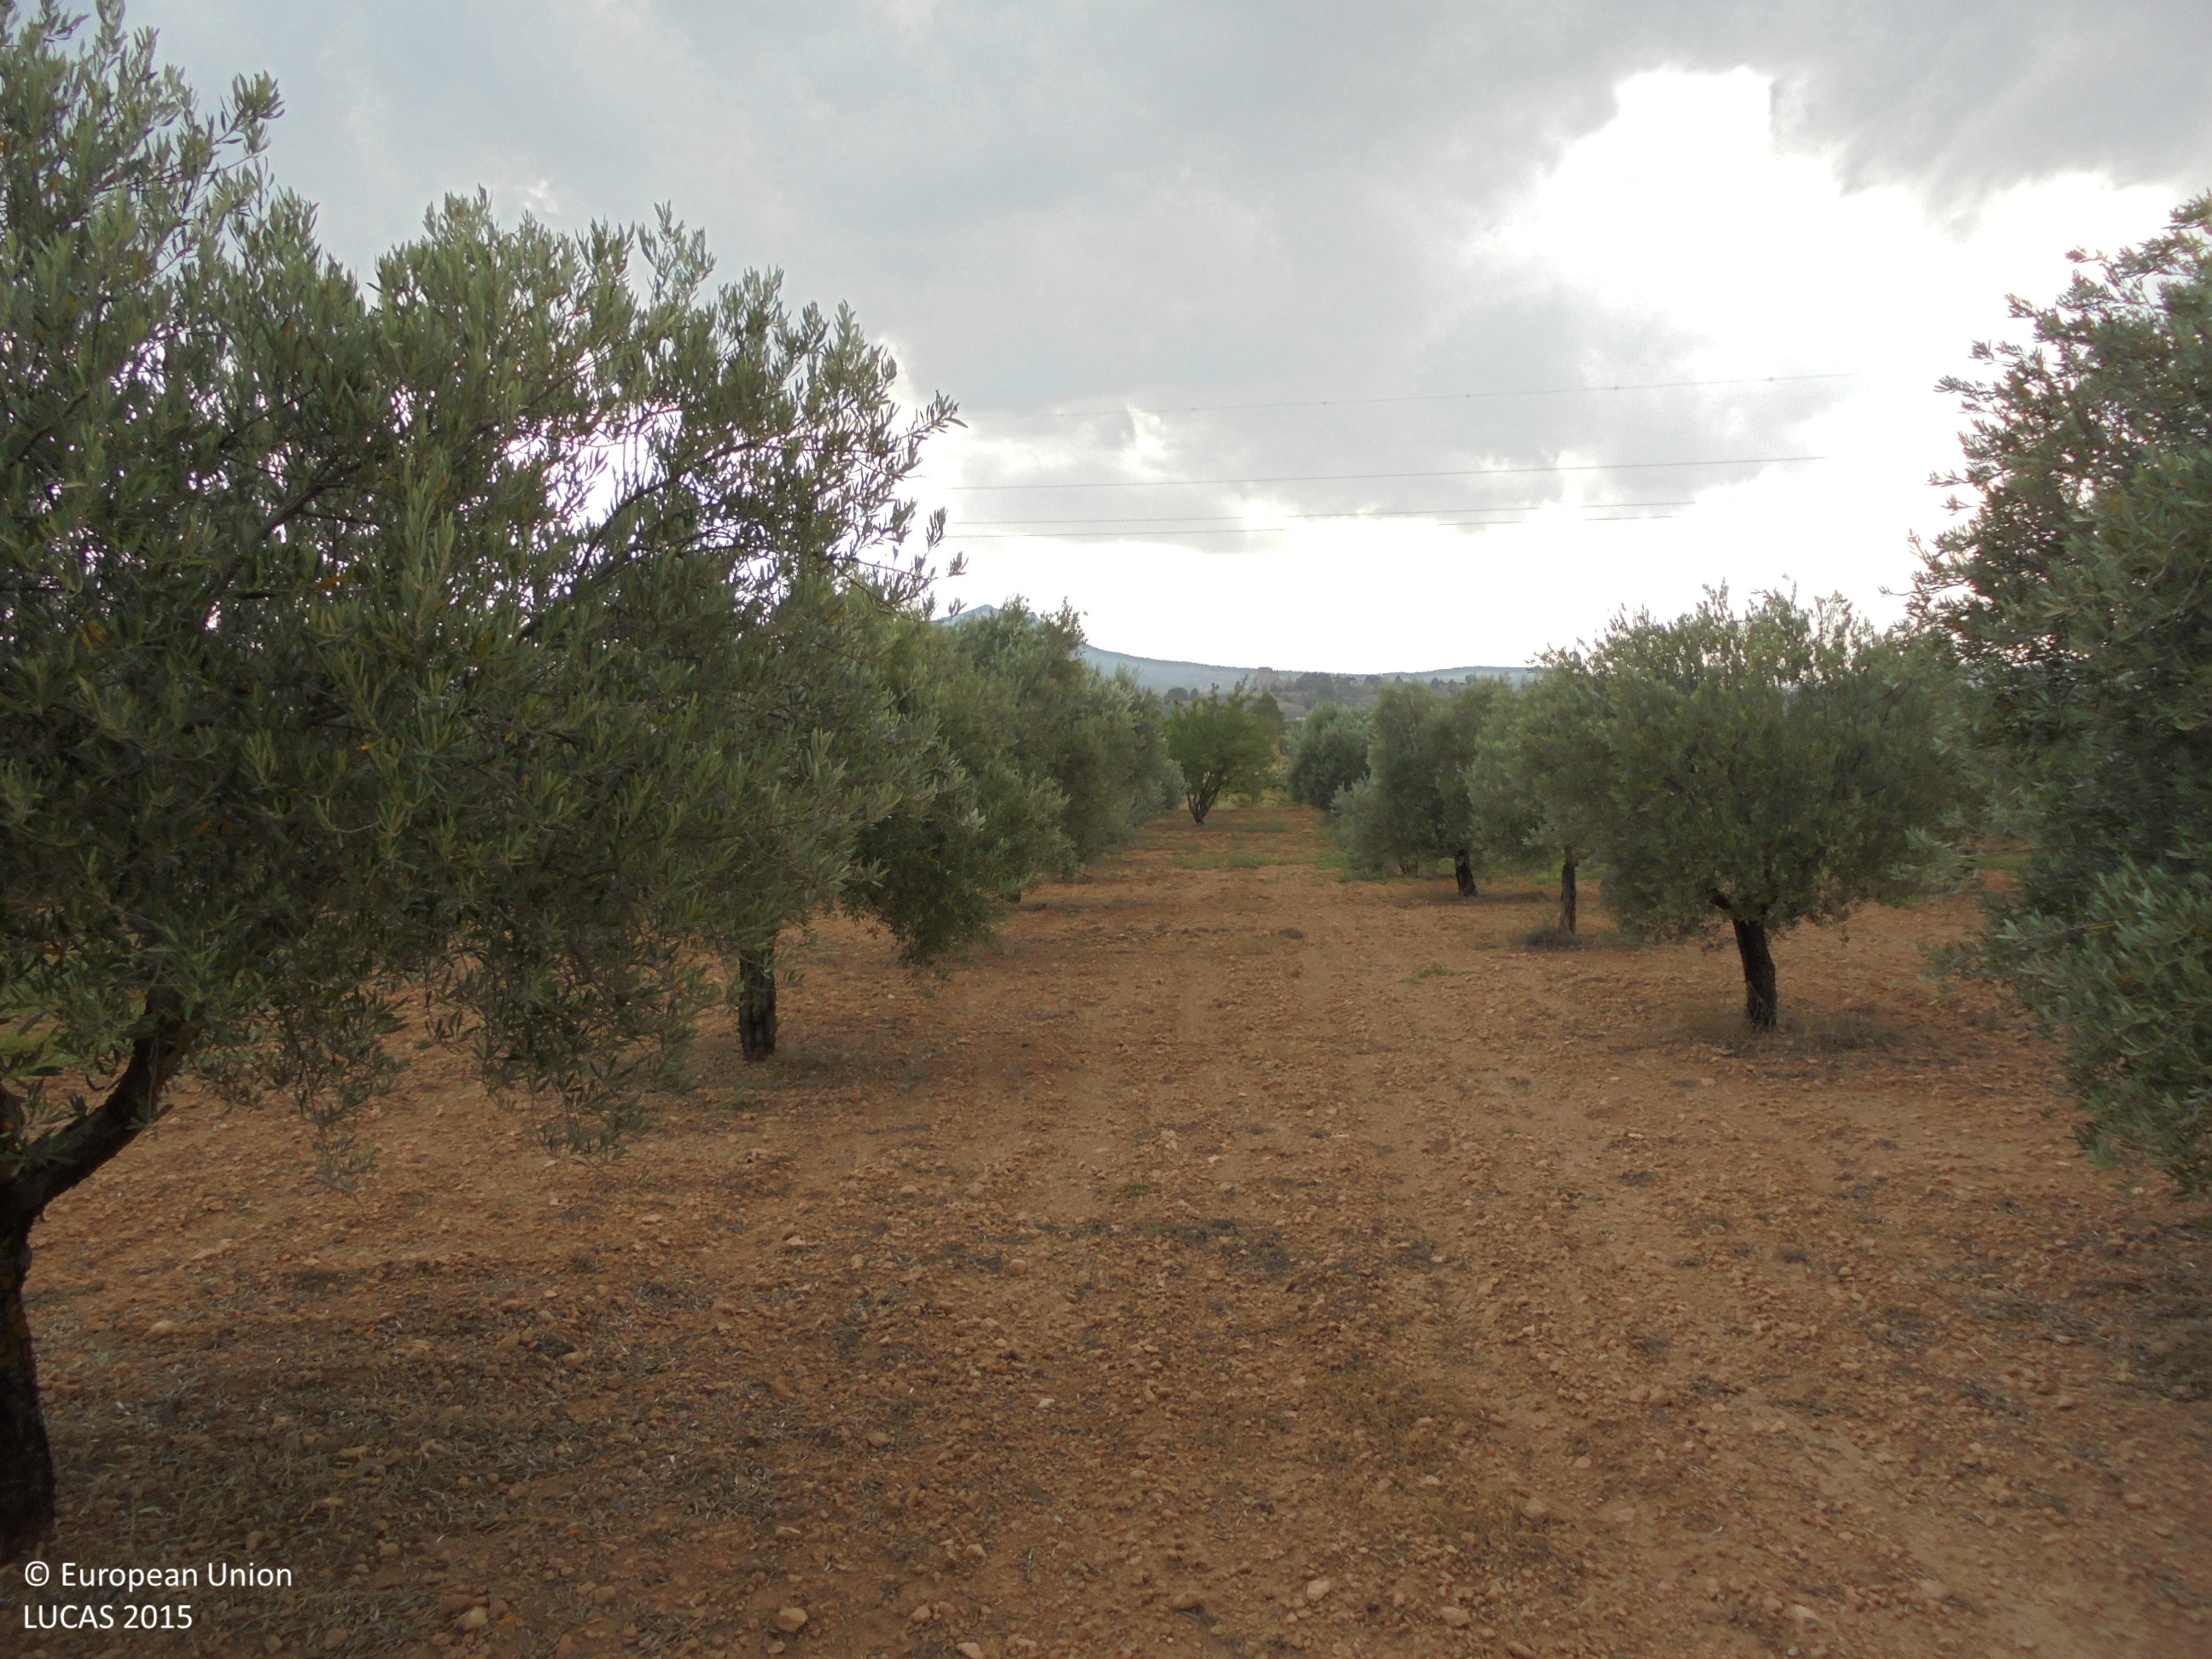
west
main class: Cropland
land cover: Olive groves
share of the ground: 25 - 50 %
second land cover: Other bare soil
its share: > 75 %
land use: Agriculture (excluding fallow land and kitchen gardens)
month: July
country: ES
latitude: 39.0591
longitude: -1.0323
